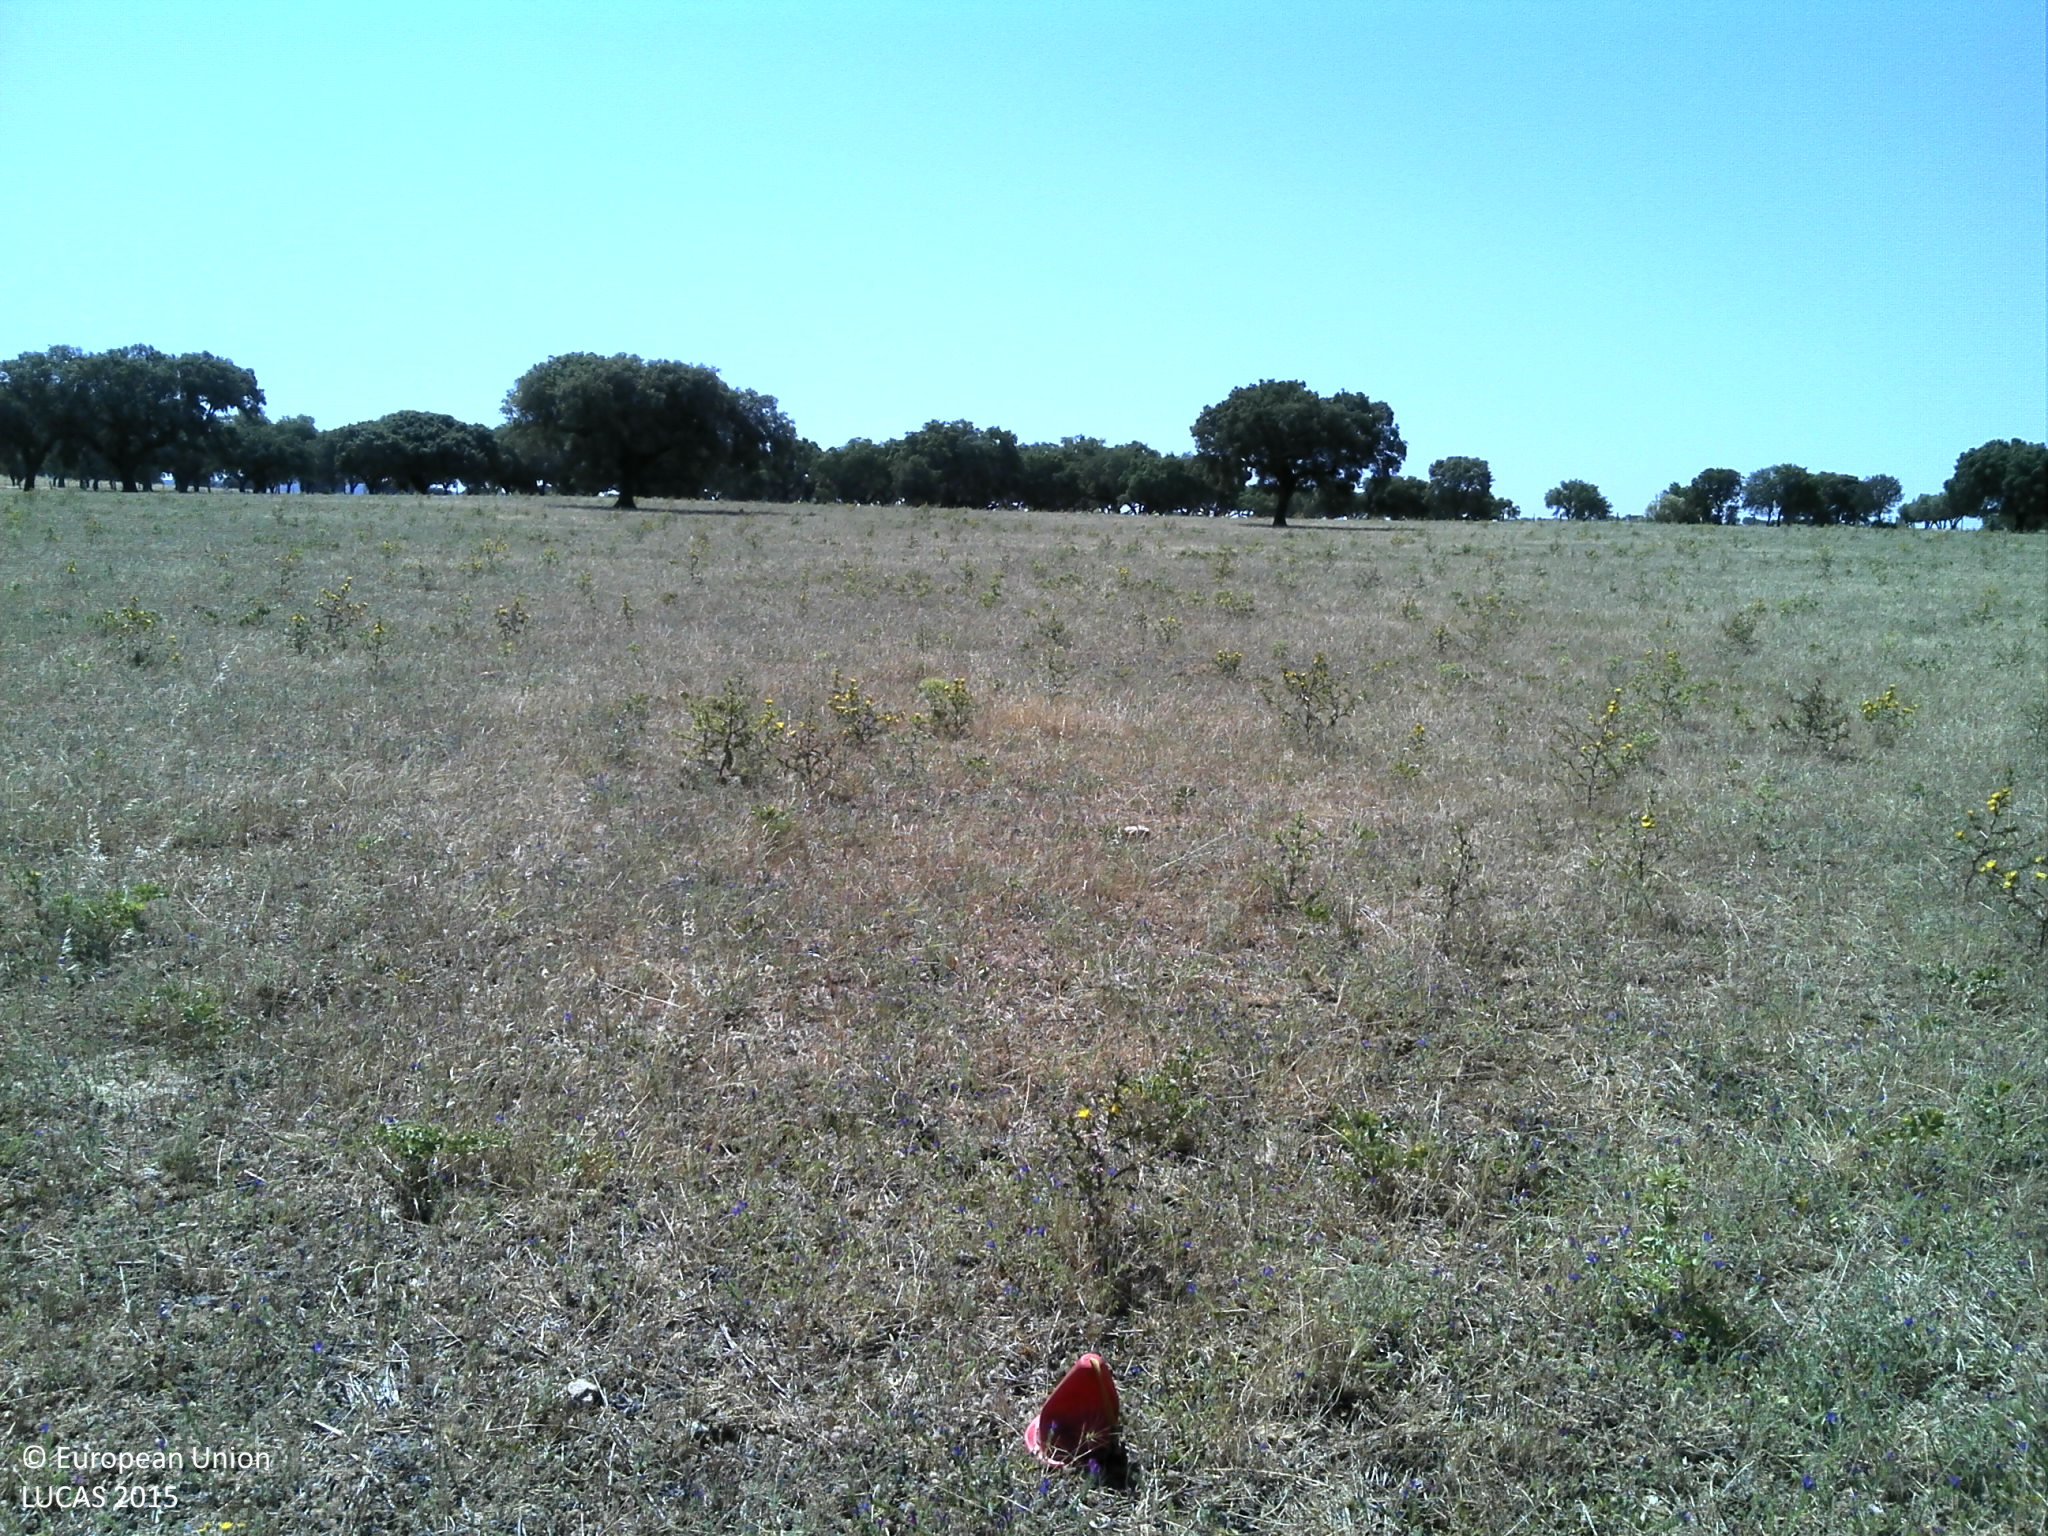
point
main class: Grassland
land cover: Grassland without tree/shrub cover
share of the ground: > 75 %
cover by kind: herbaceous plants 90 %, unconsolidated bare surface 10 %
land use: Agriculture (excluding fallow land and kitchen gardens)
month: June
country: PT
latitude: 38.8034
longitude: -7.8326
